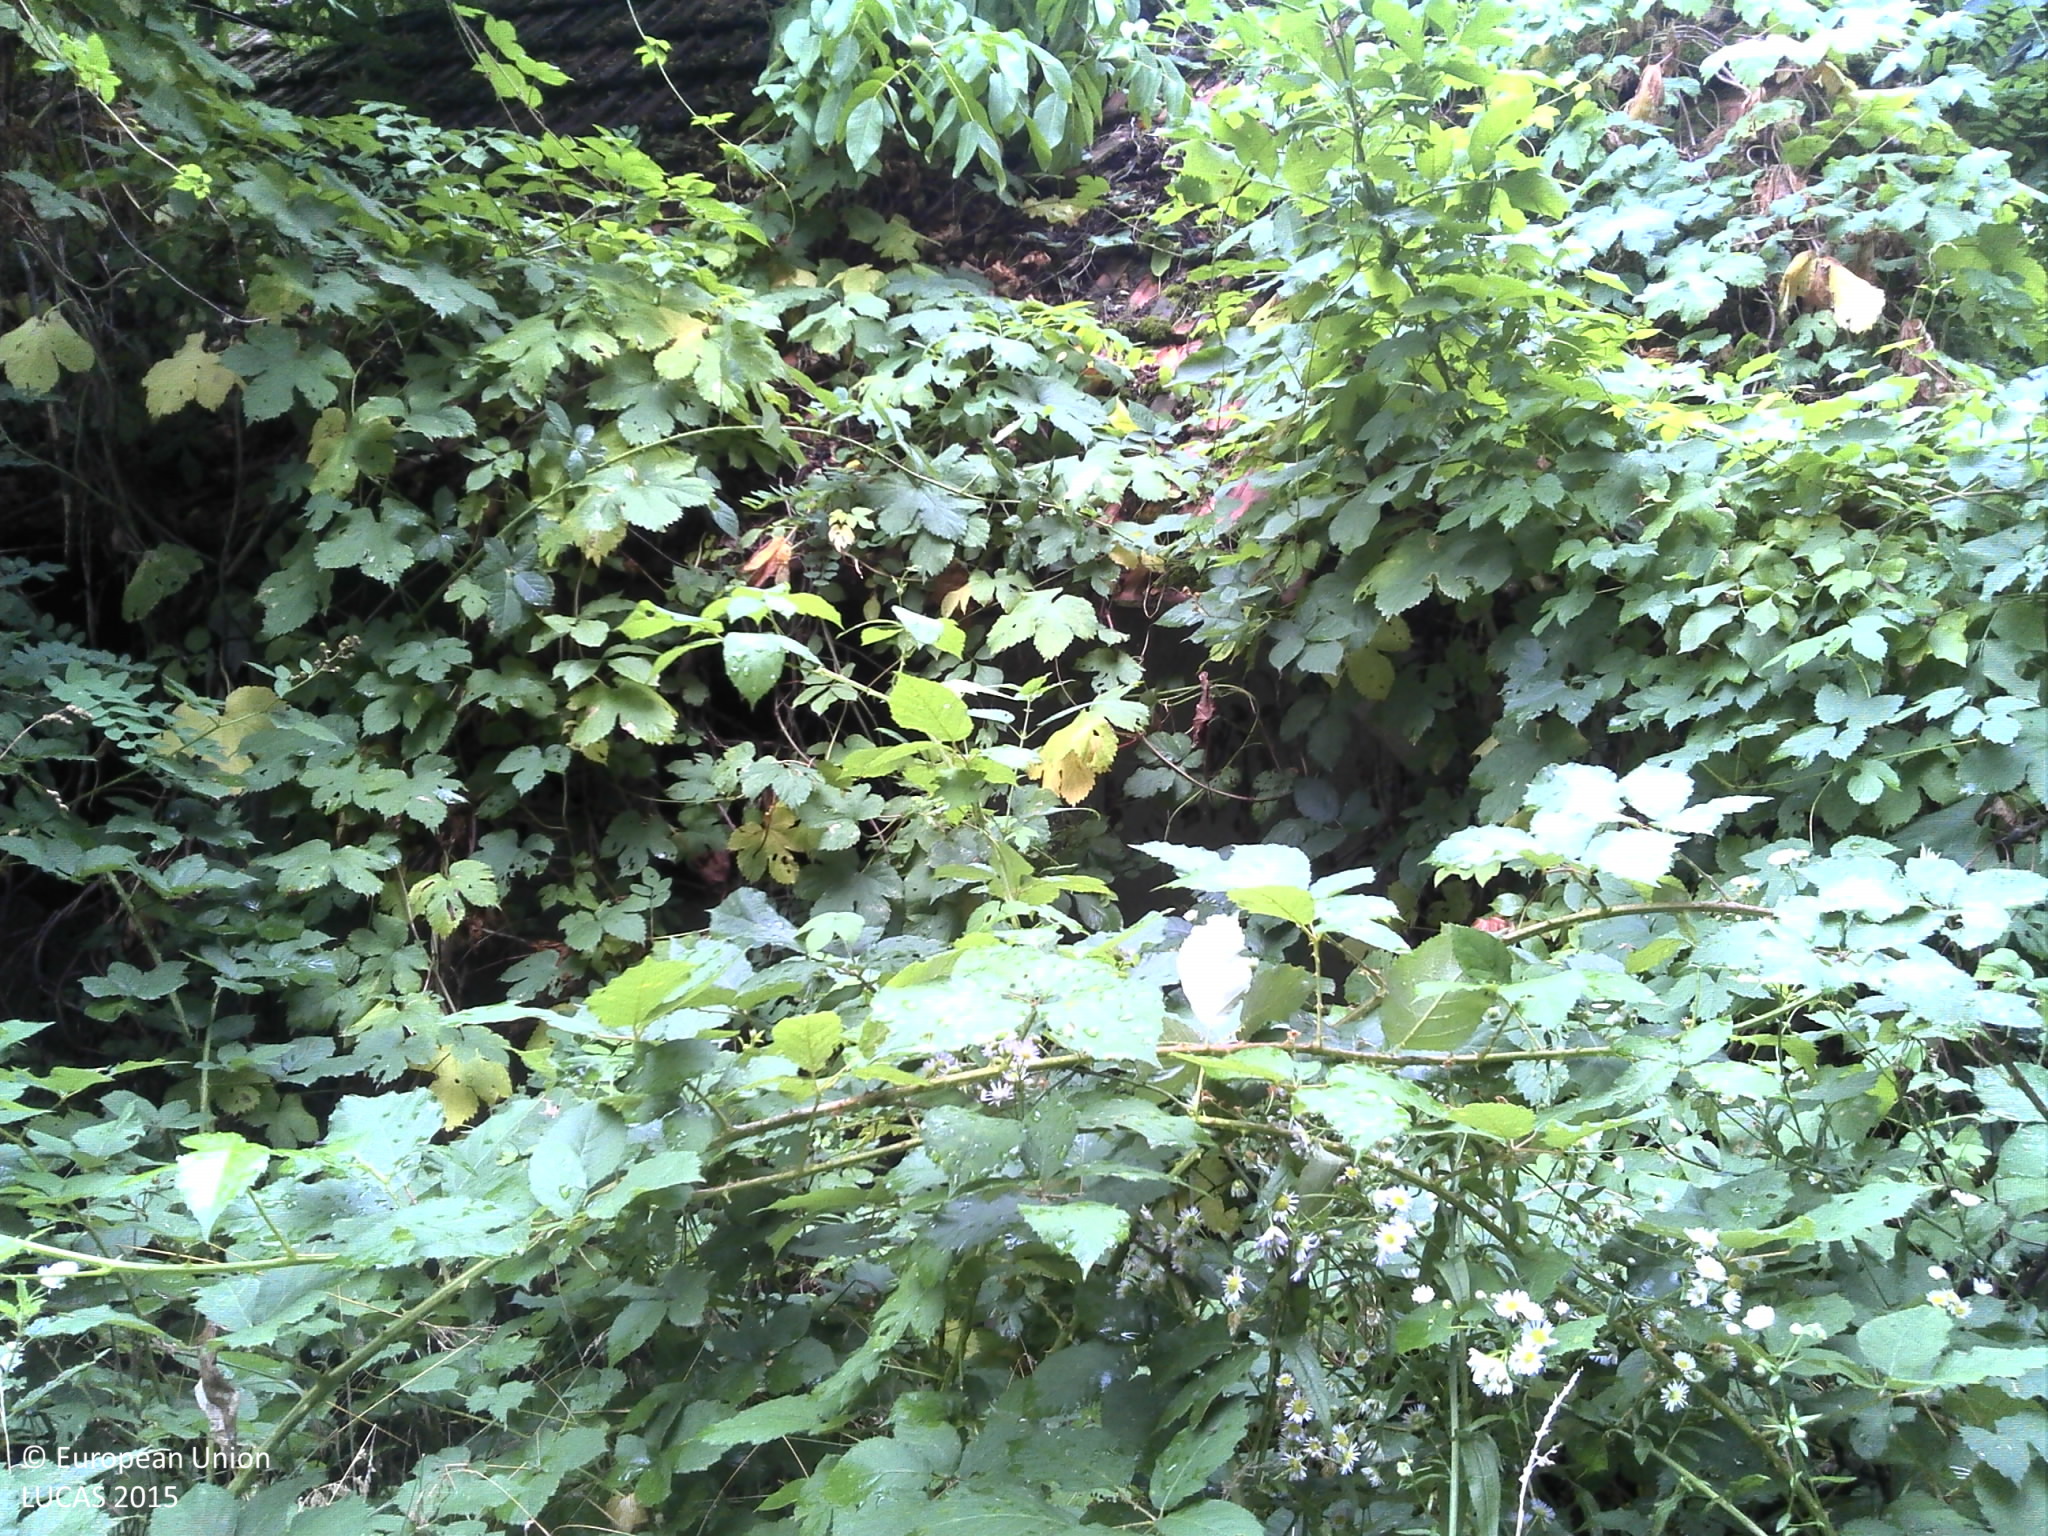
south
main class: Grassland
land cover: Spontaneously vegetated surfaces
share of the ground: > 75 %
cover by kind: herbaceous plants 95 %, shrubs 5 %
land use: Semi-natural and natural areas not in use
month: July
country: HR
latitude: 45.8919
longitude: 16.9212
